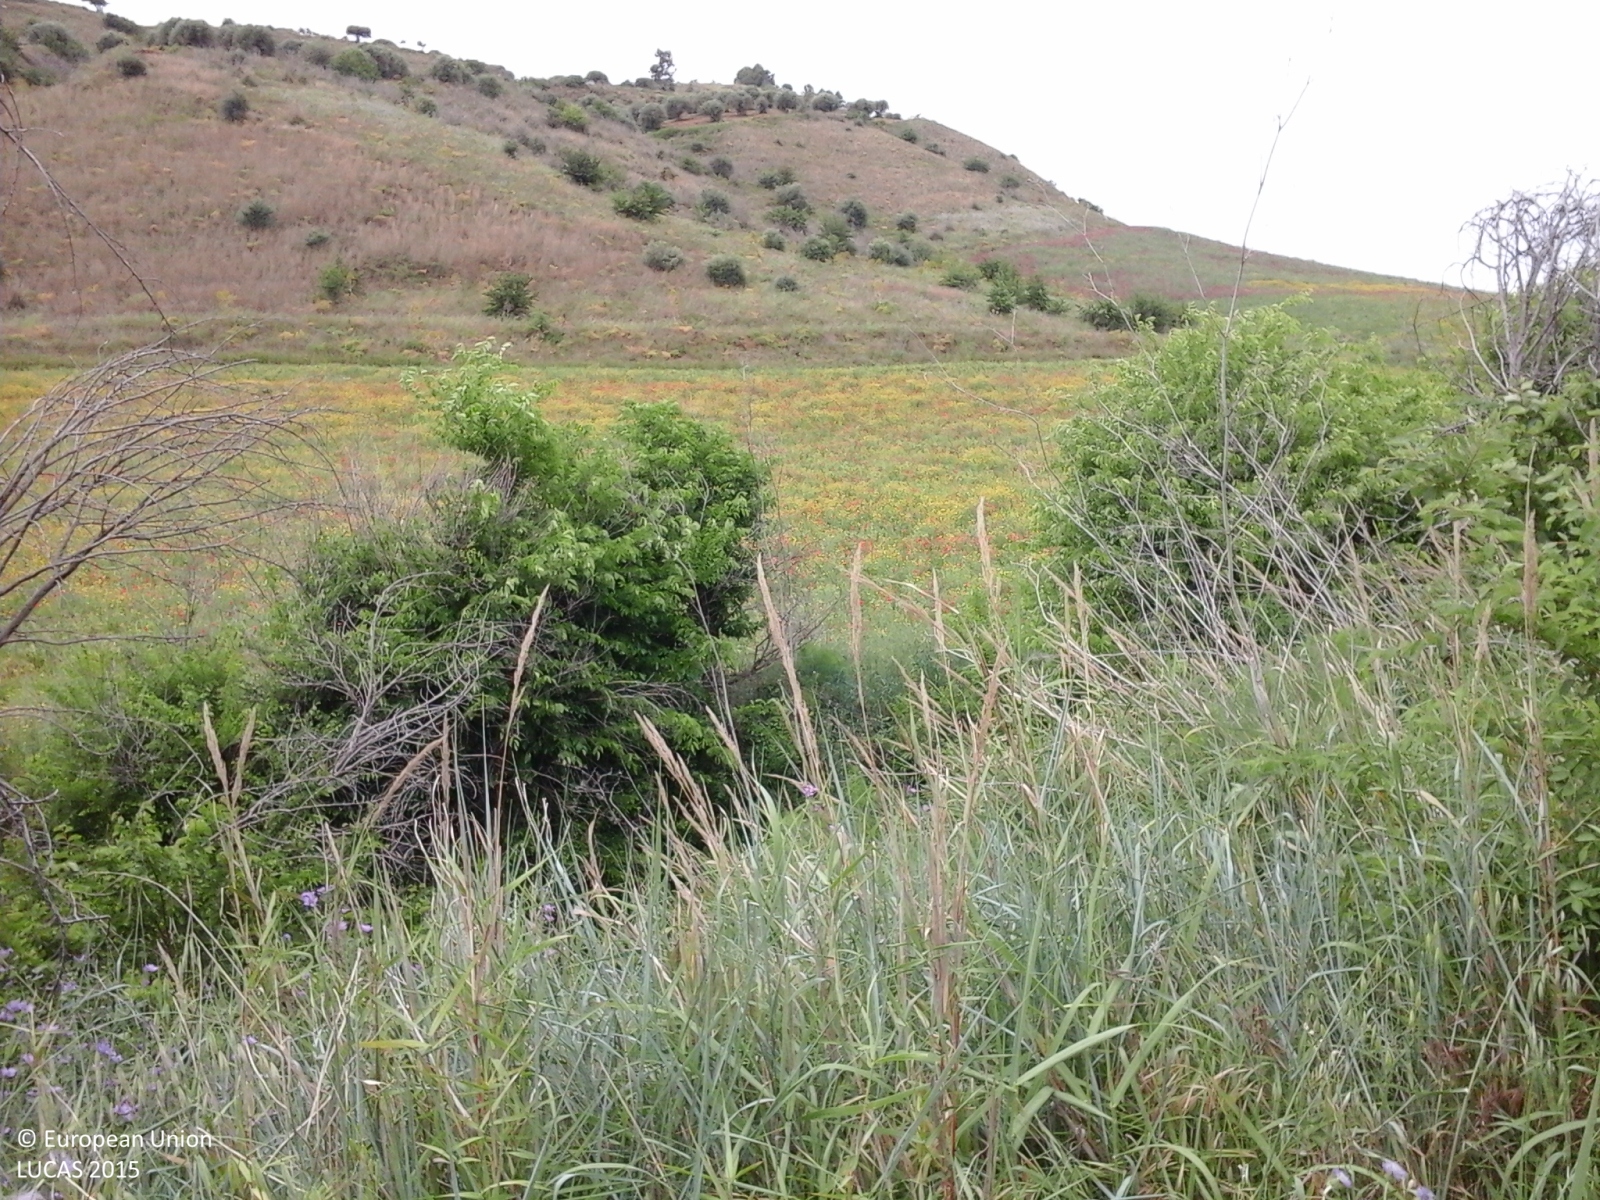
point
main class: Grassland
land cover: Spontaneously vegetated surfaces
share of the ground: > 75 %
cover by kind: herbaceous plants 100 %
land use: Agriculture (excluding fallow land and kitchen gardens)
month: May
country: IT
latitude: 37.6645
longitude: 13.9727
